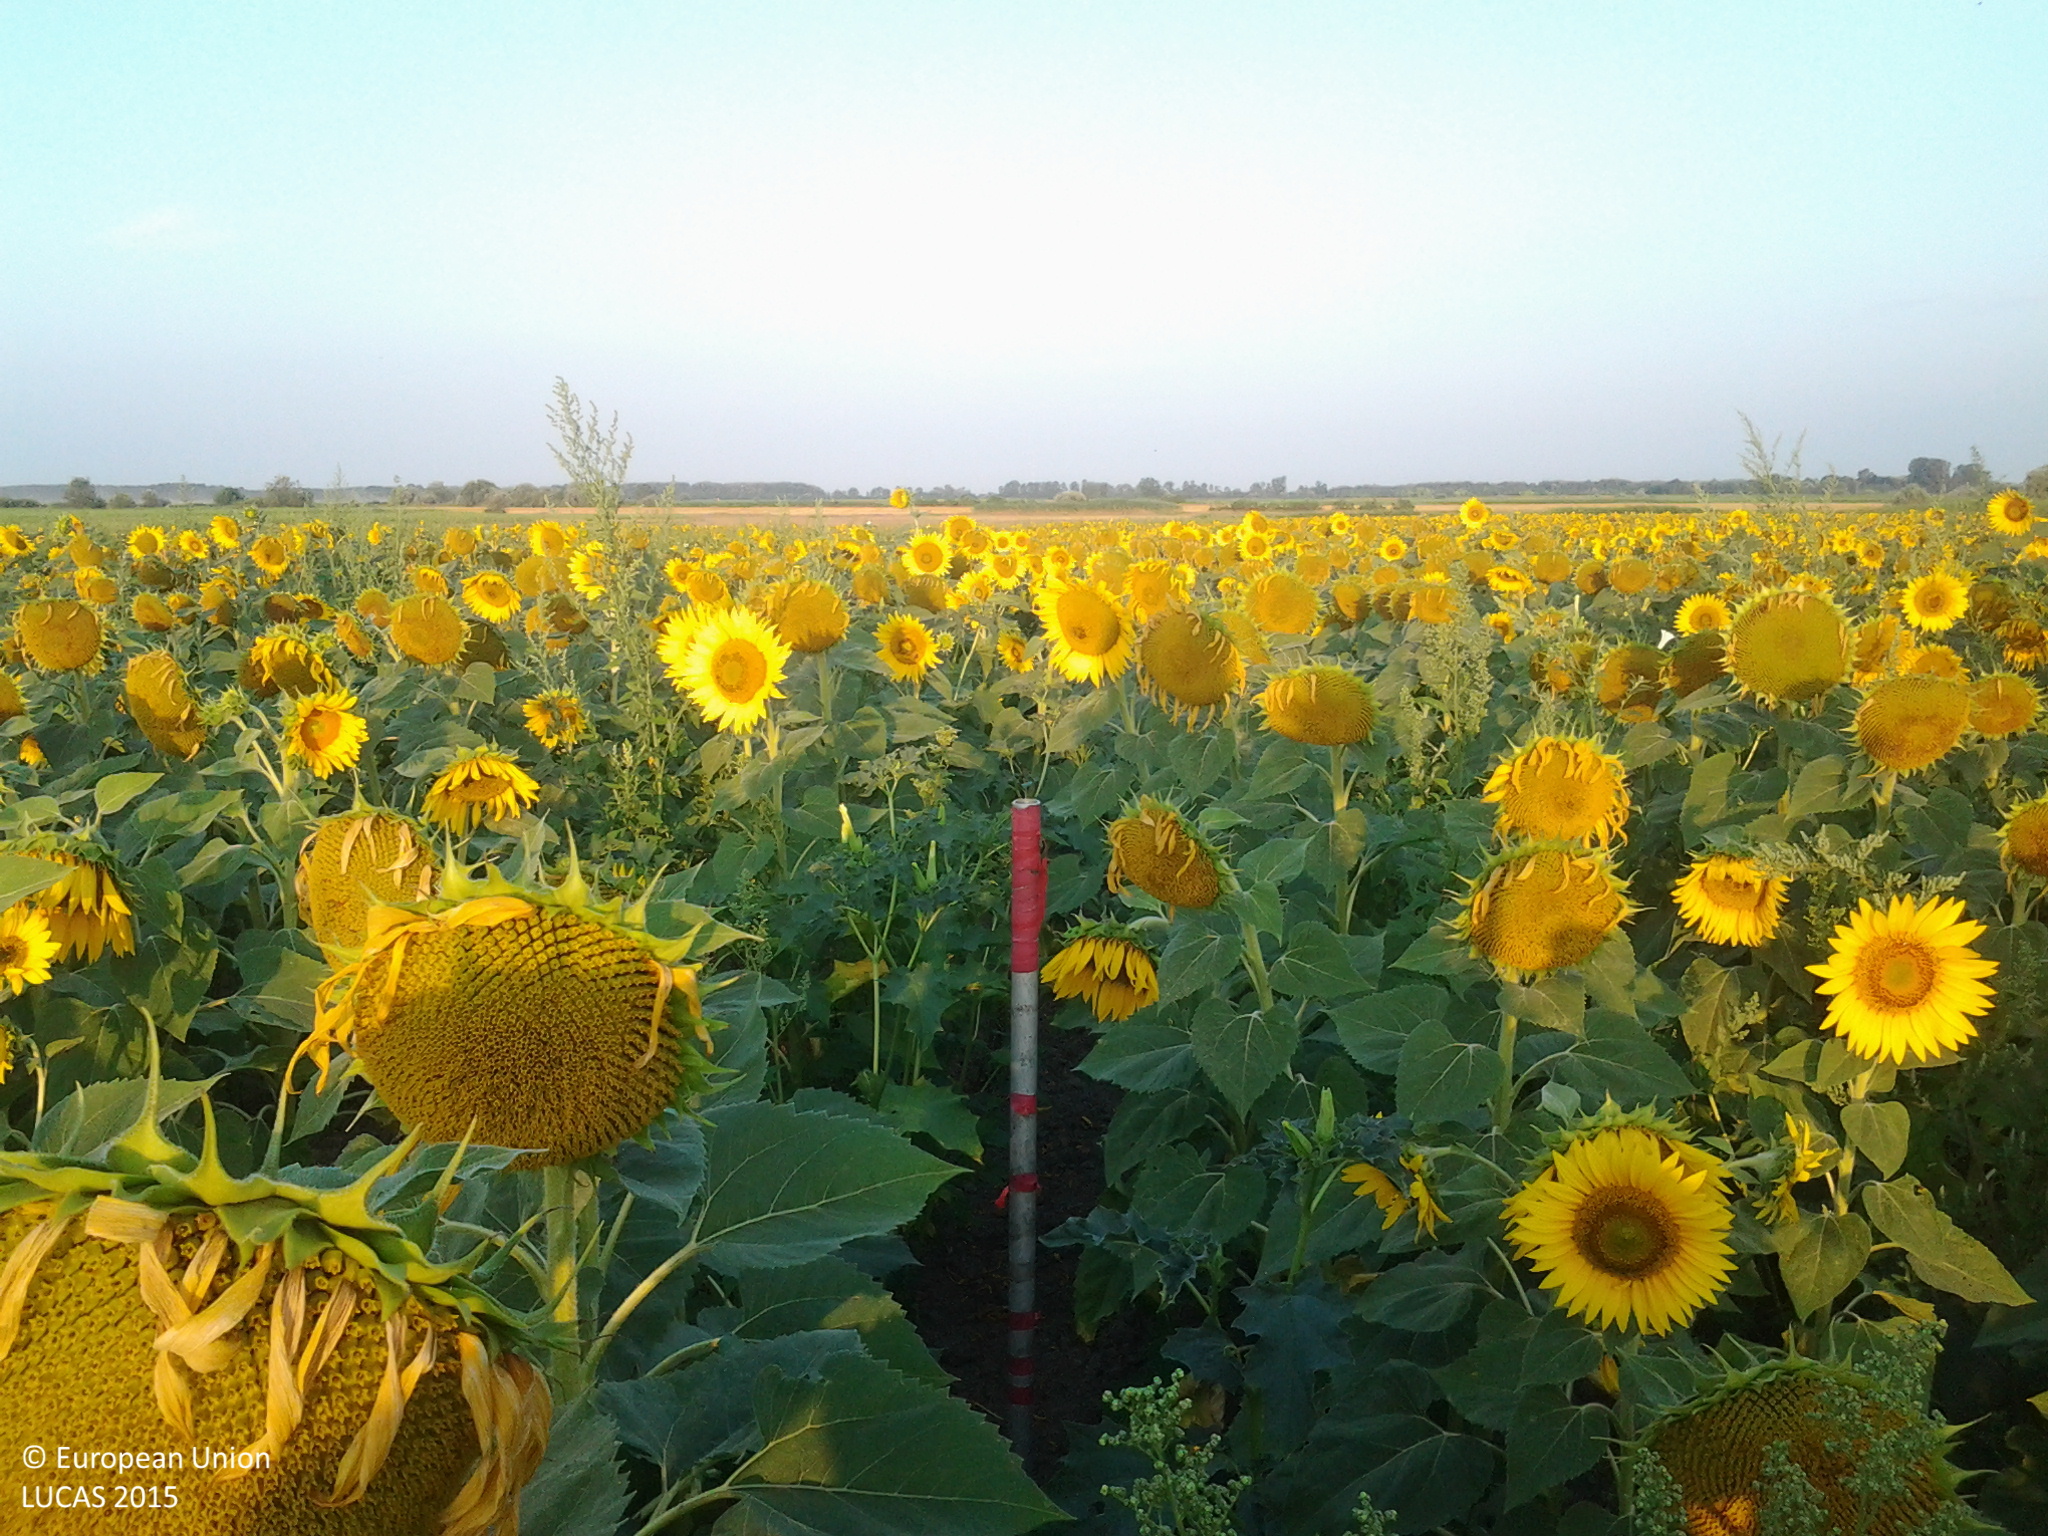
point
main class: Cropland
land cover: Sunflower
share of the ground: > 75 %
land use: Agriculture (excluding fallow land and kitchen gardens)
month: July
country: HU
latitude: 46.8813
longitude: 19.1625
